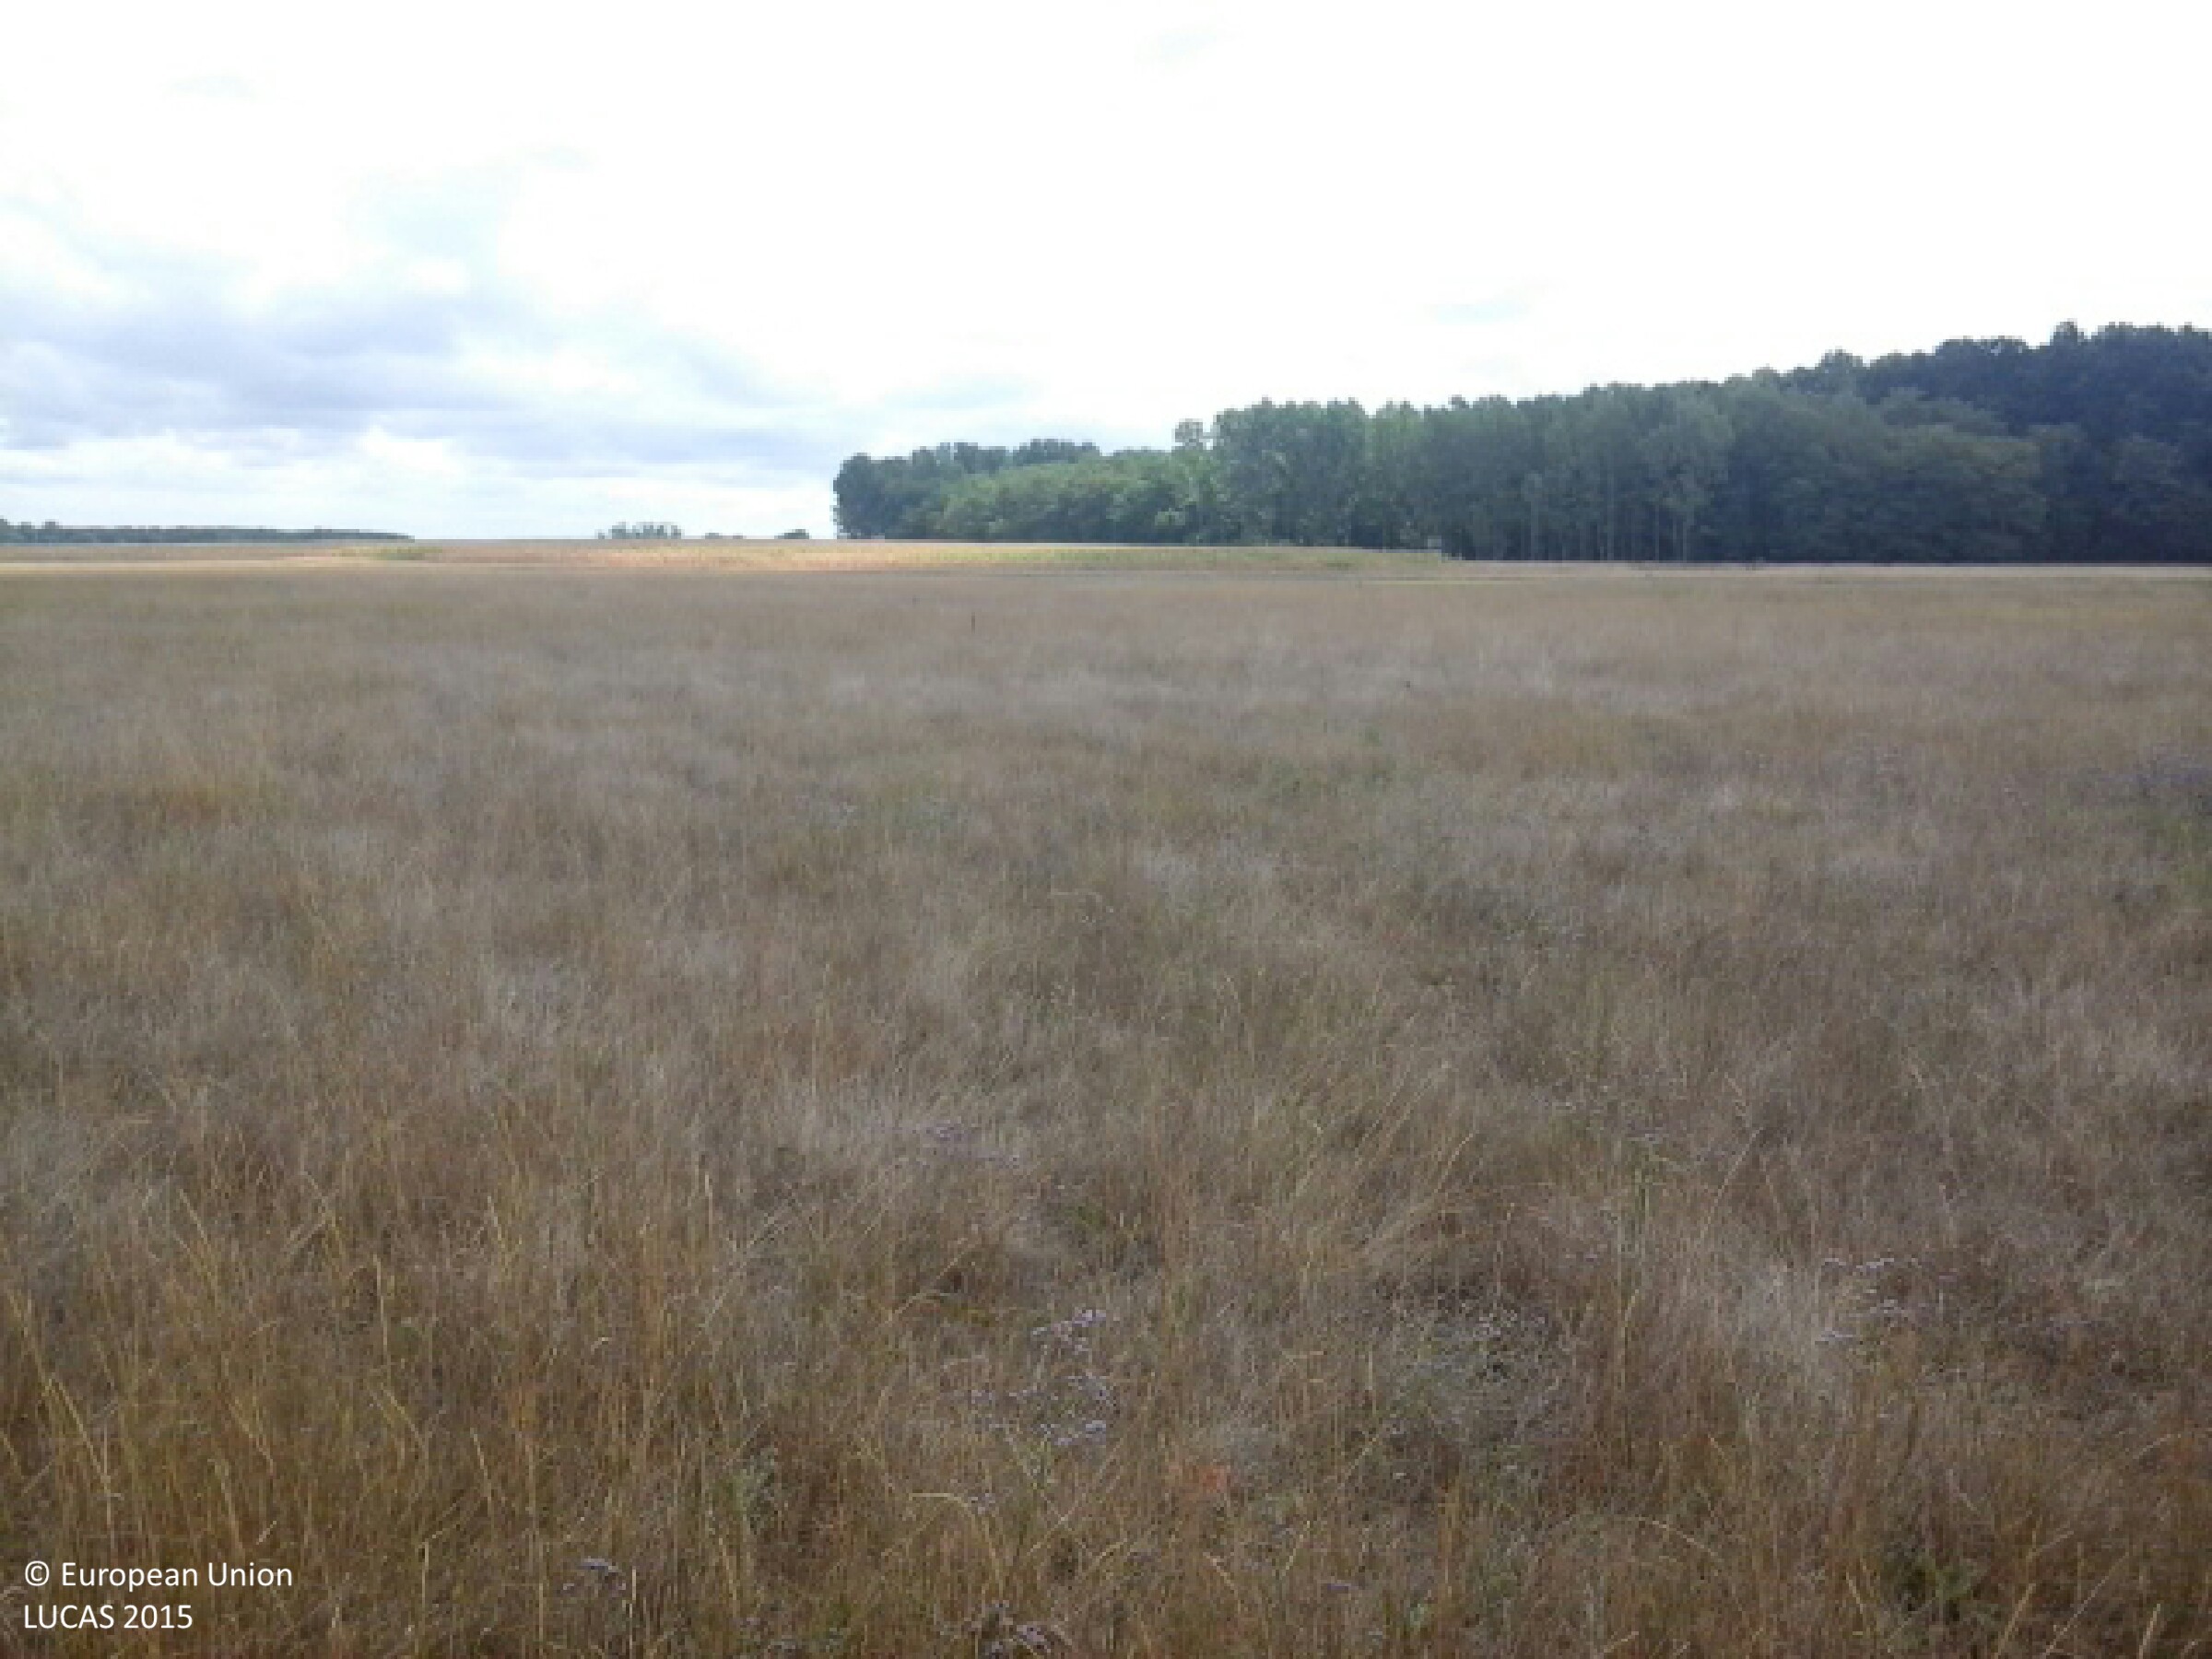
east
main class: Grassland
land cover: Grassland without tree/shrub cover
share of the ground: > 75 %
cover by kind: herbaceous plants 100 %
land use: Semi-natural and natural areas not in use
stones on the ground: < 10 %
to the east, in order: Grassland without tree/shrub cover; Maize
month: August
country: HU
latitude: 47.0880
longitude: 21.5411
